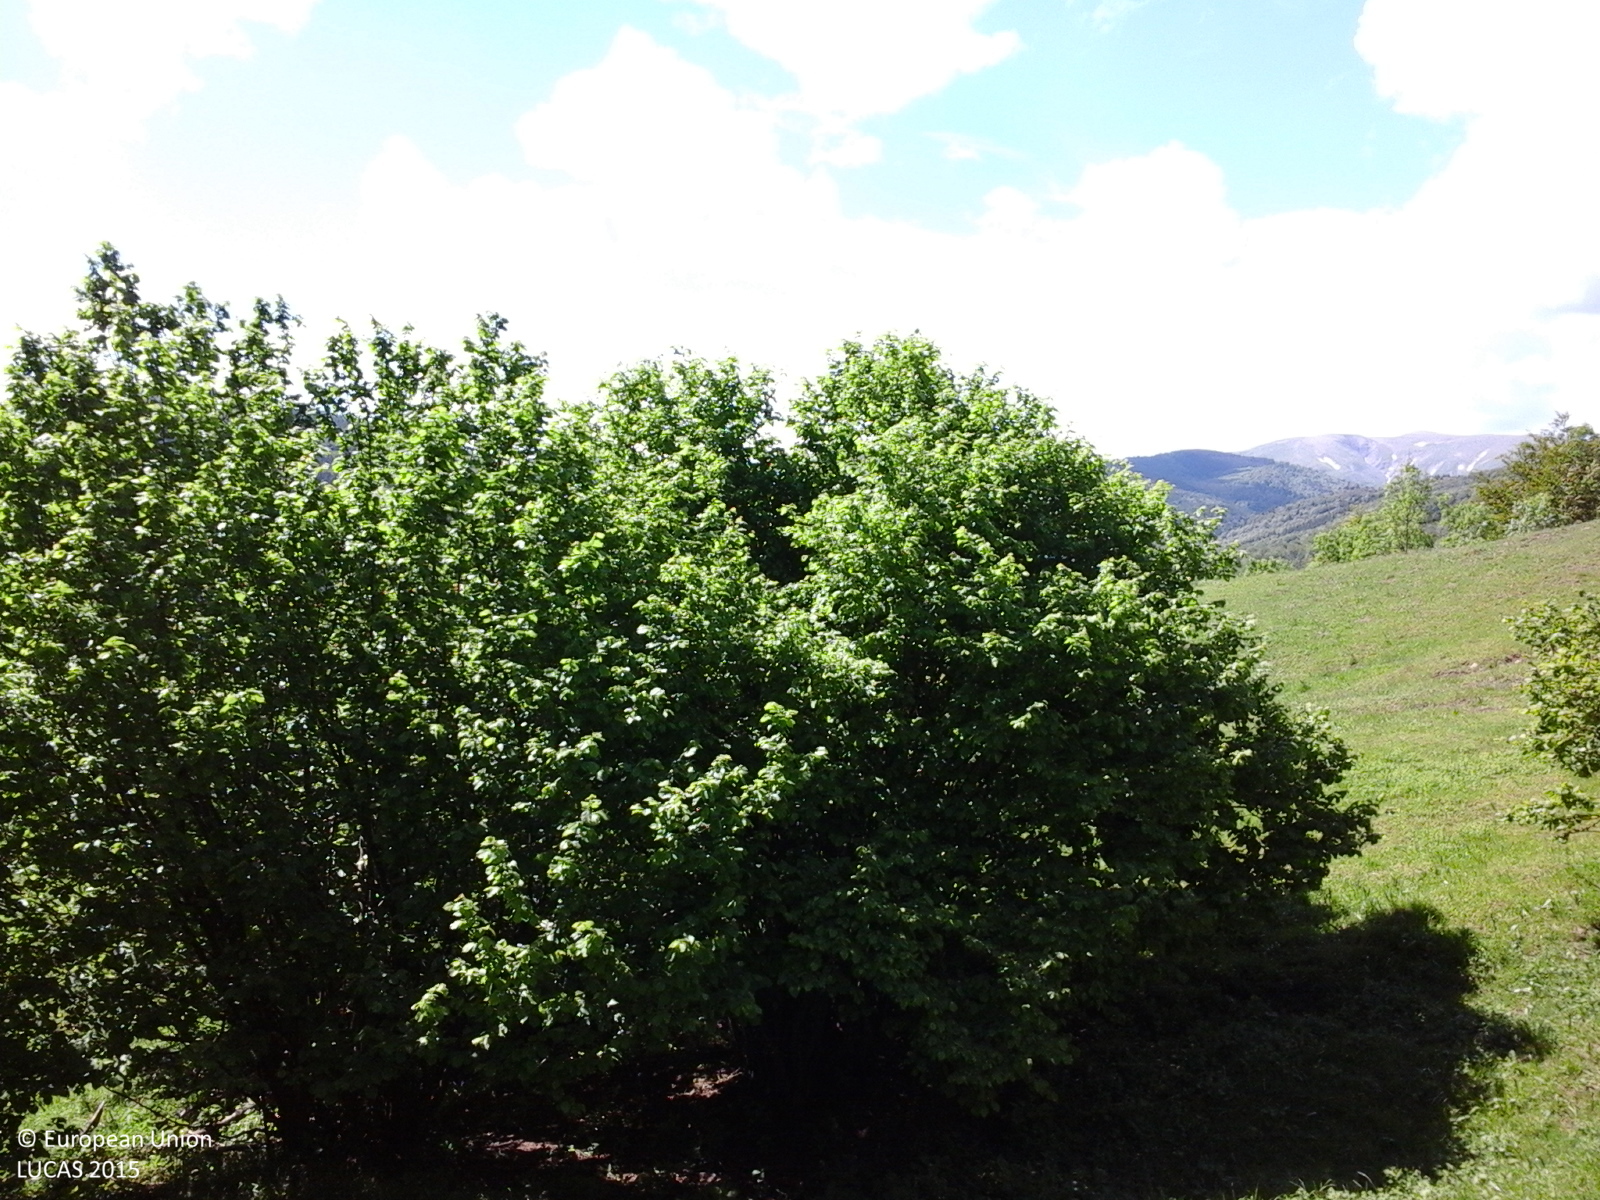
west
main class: Grassland
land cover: Grassland without tree/shrub cover
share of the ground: > 75 %
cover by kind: herbaceous plants 100 %
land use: Agriculture (excluding fallow land and kitchen gardens)
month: May
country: RO
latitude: 45.3770
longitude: 25.7487
